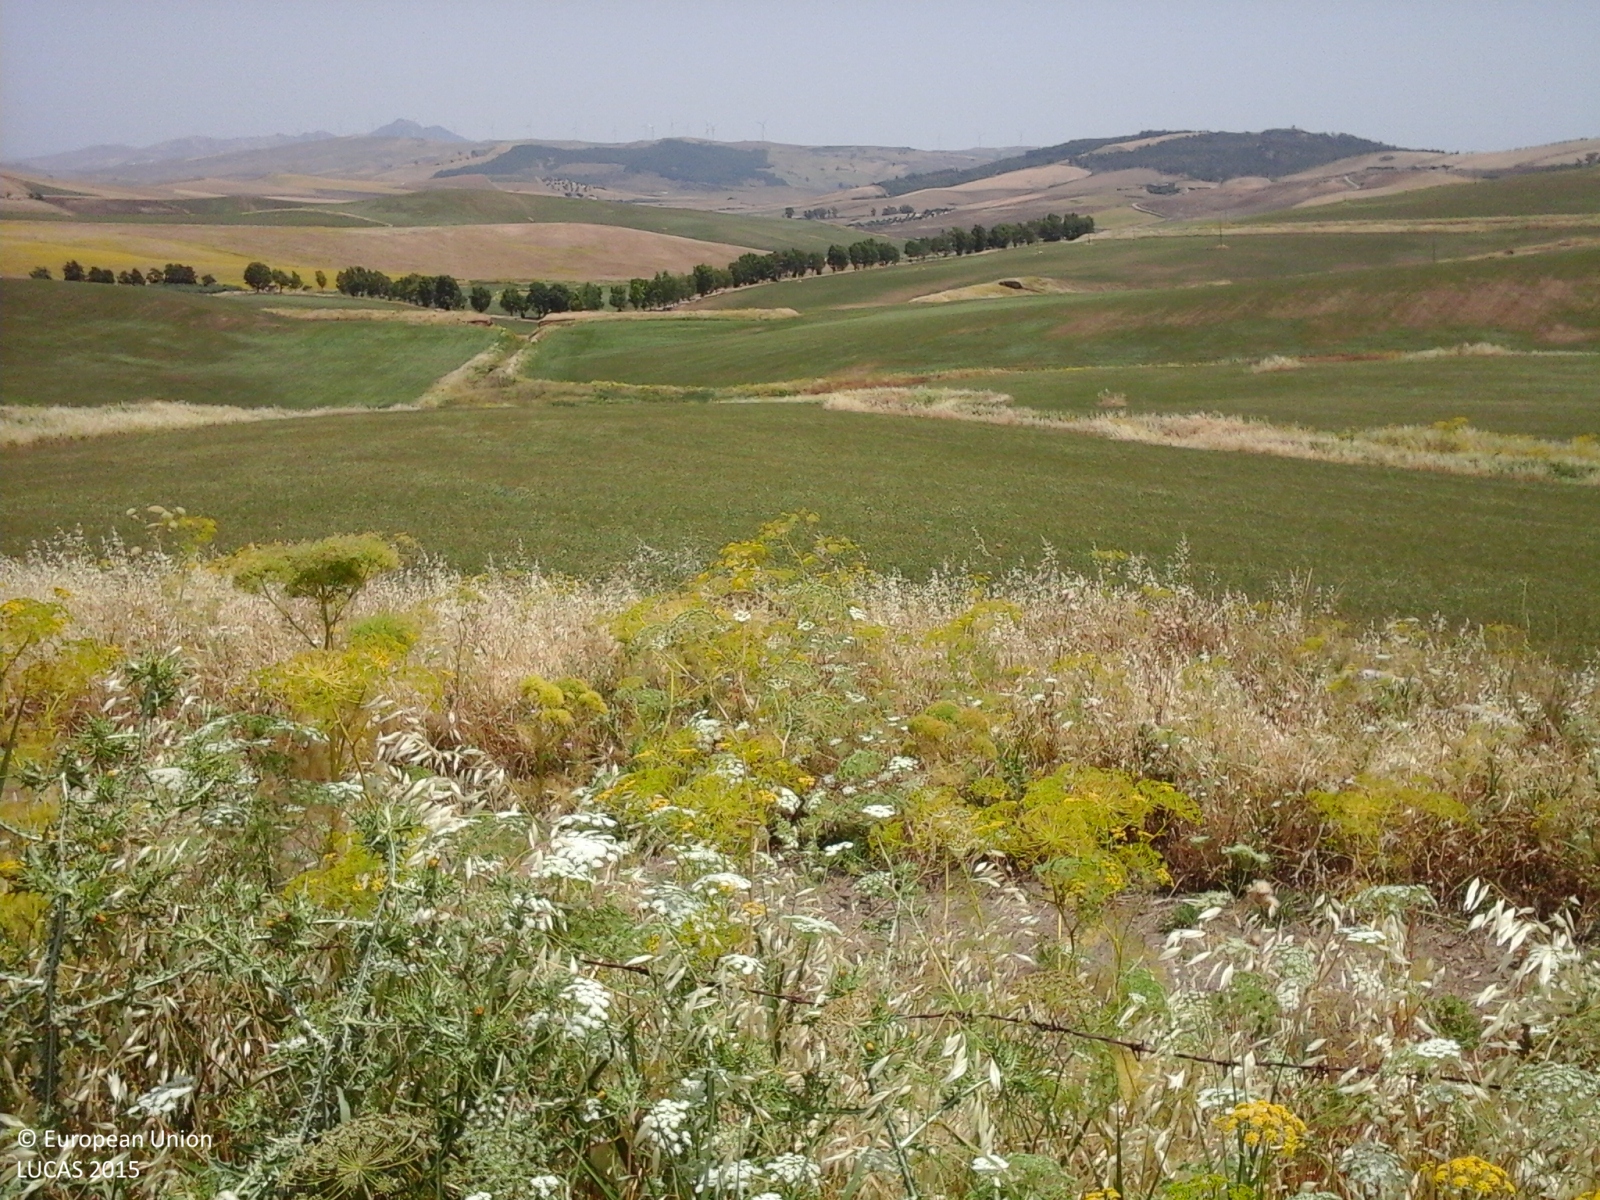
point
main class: Cropland
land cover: Clovers
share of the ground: > 75 %
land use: Agriculture (excluding fallow land and kitchen gardens)
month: June
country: IT
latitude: 37.4976
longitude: 14.4577
